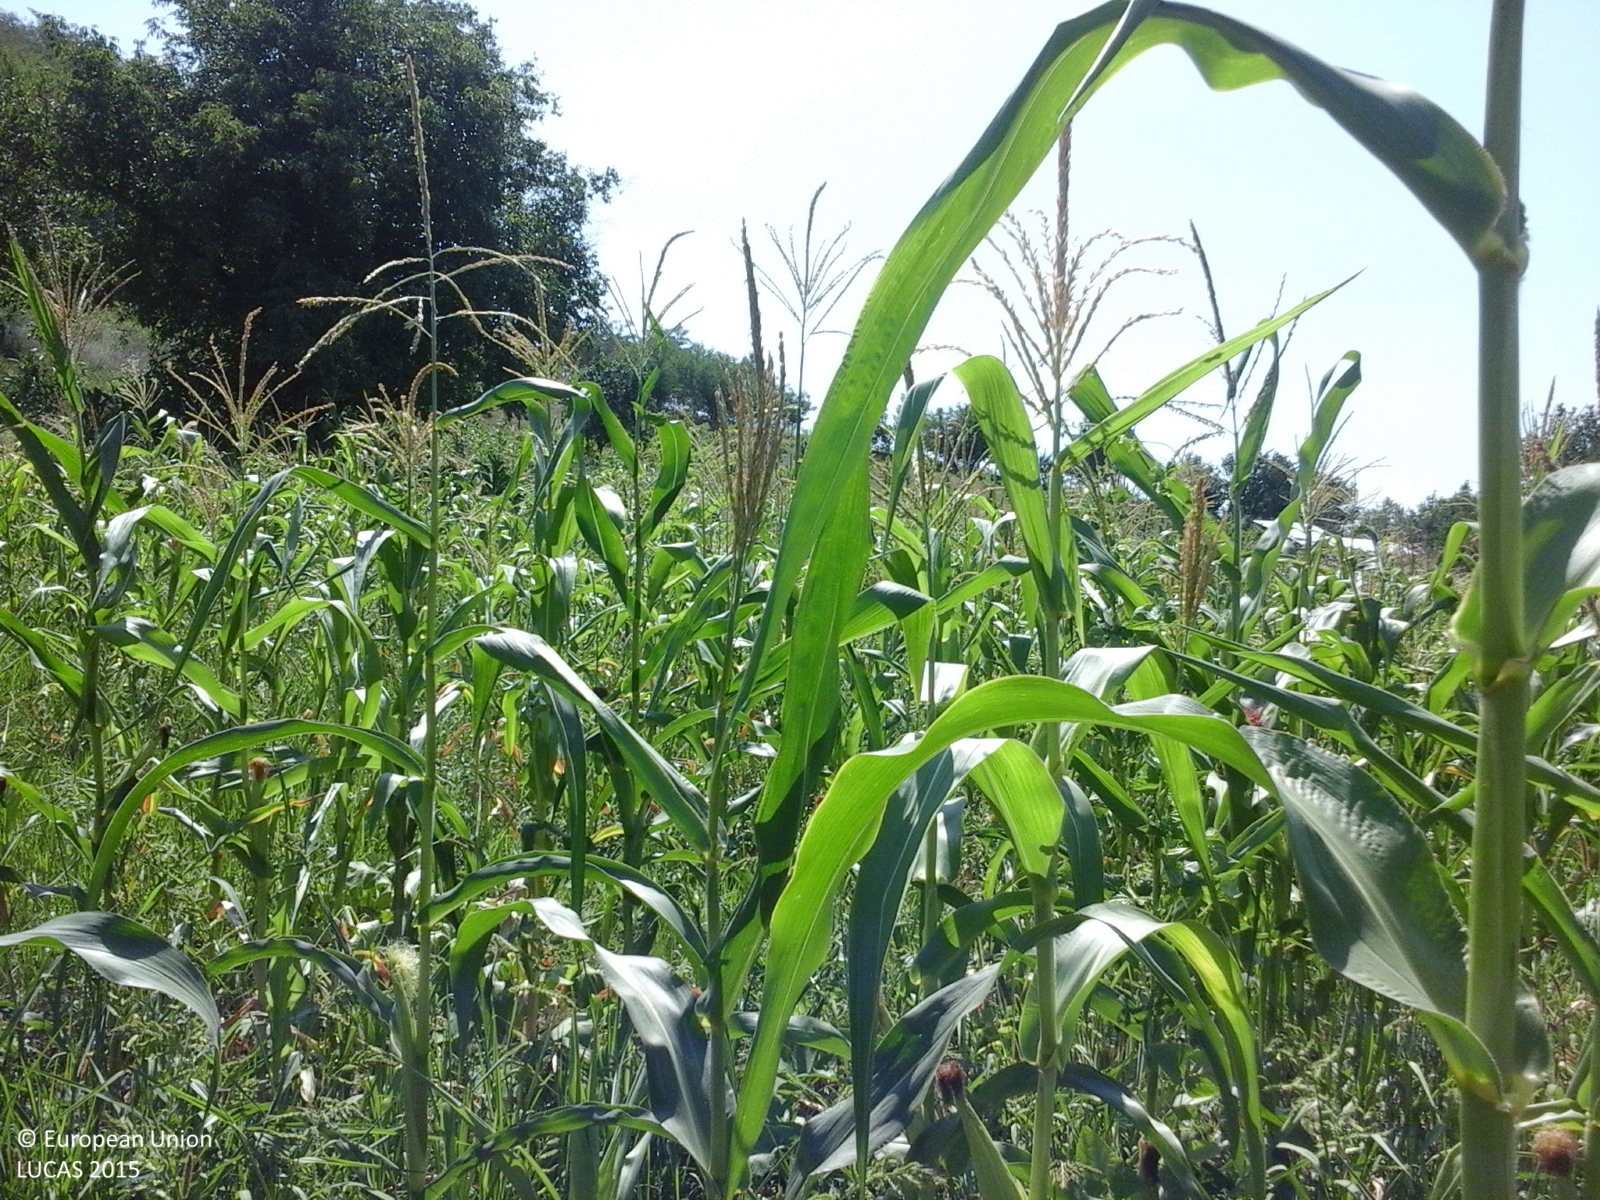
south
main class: Cropland
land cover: Maize
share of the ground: > 75 %
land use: Agriculture (excluding fallow land and kitchen gardens)
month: July
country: RO
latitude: 46.5063
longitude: 27.2128
